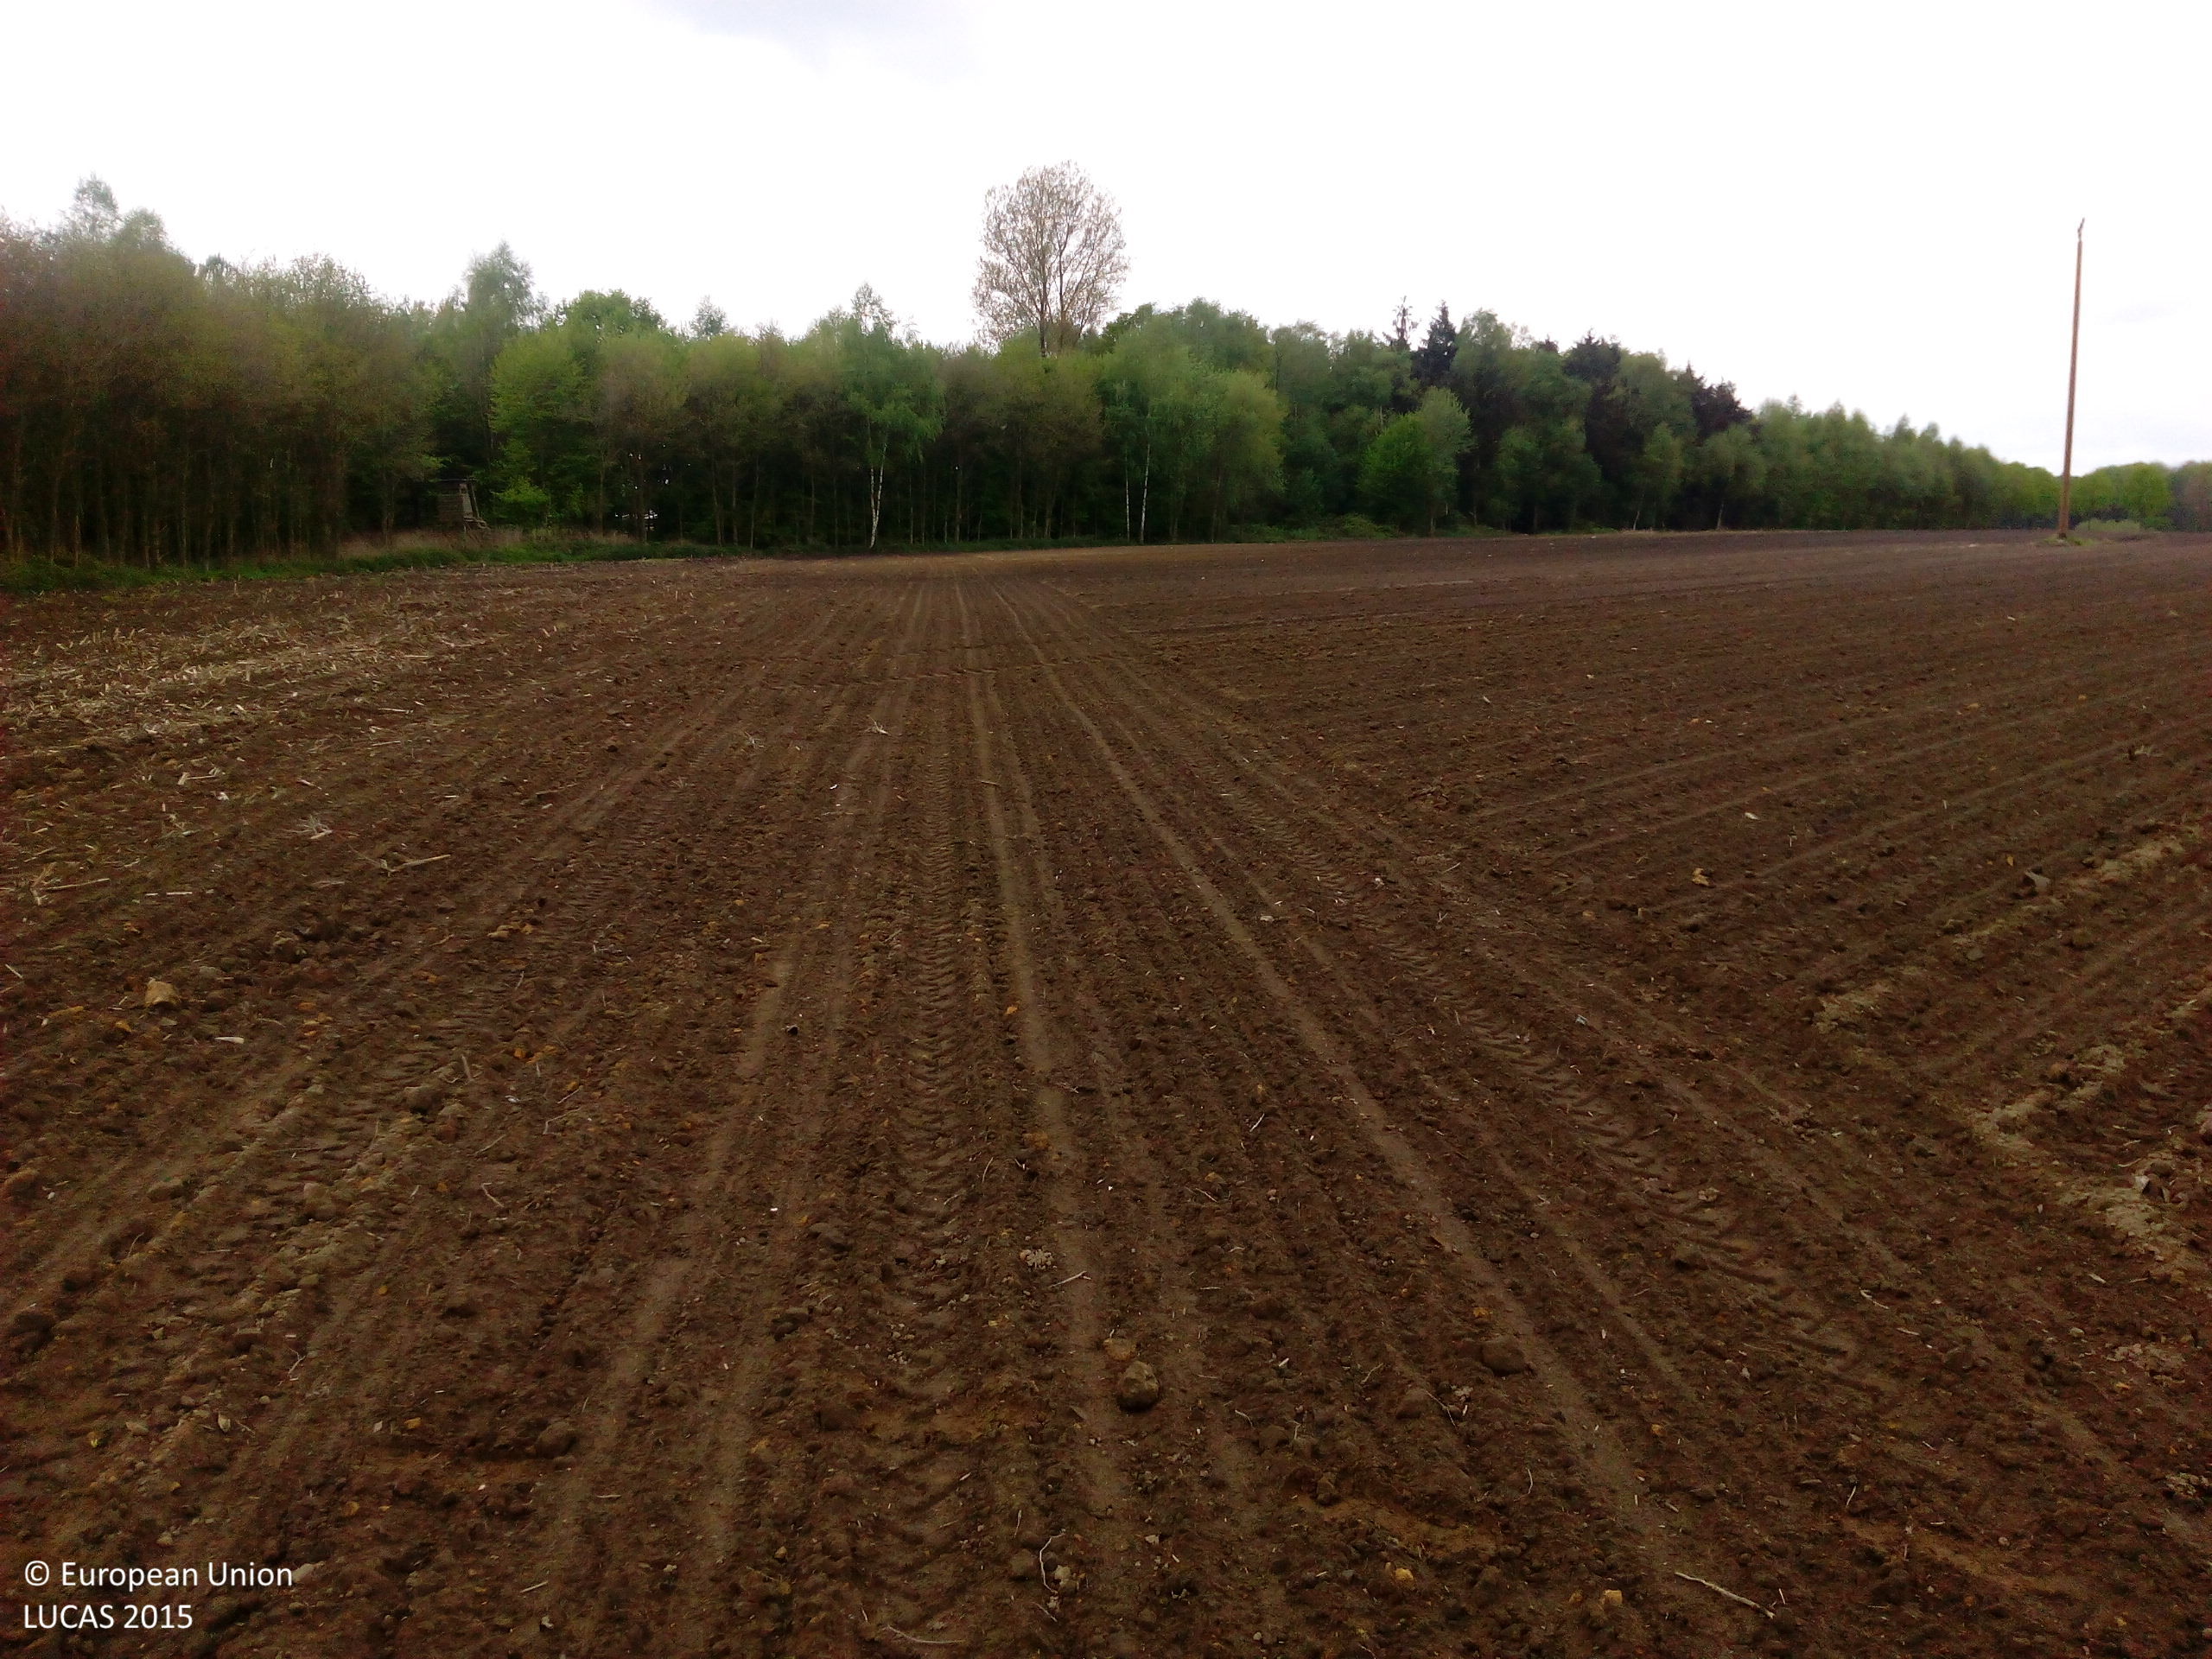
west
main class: Cropland
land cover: Maize
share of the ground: < 10 %
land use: Agriculture (excluding fallow land and kitchen gardens)
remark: Tilled/Sowed
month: May
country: DE
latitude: 51.7910
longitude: 7.3761
